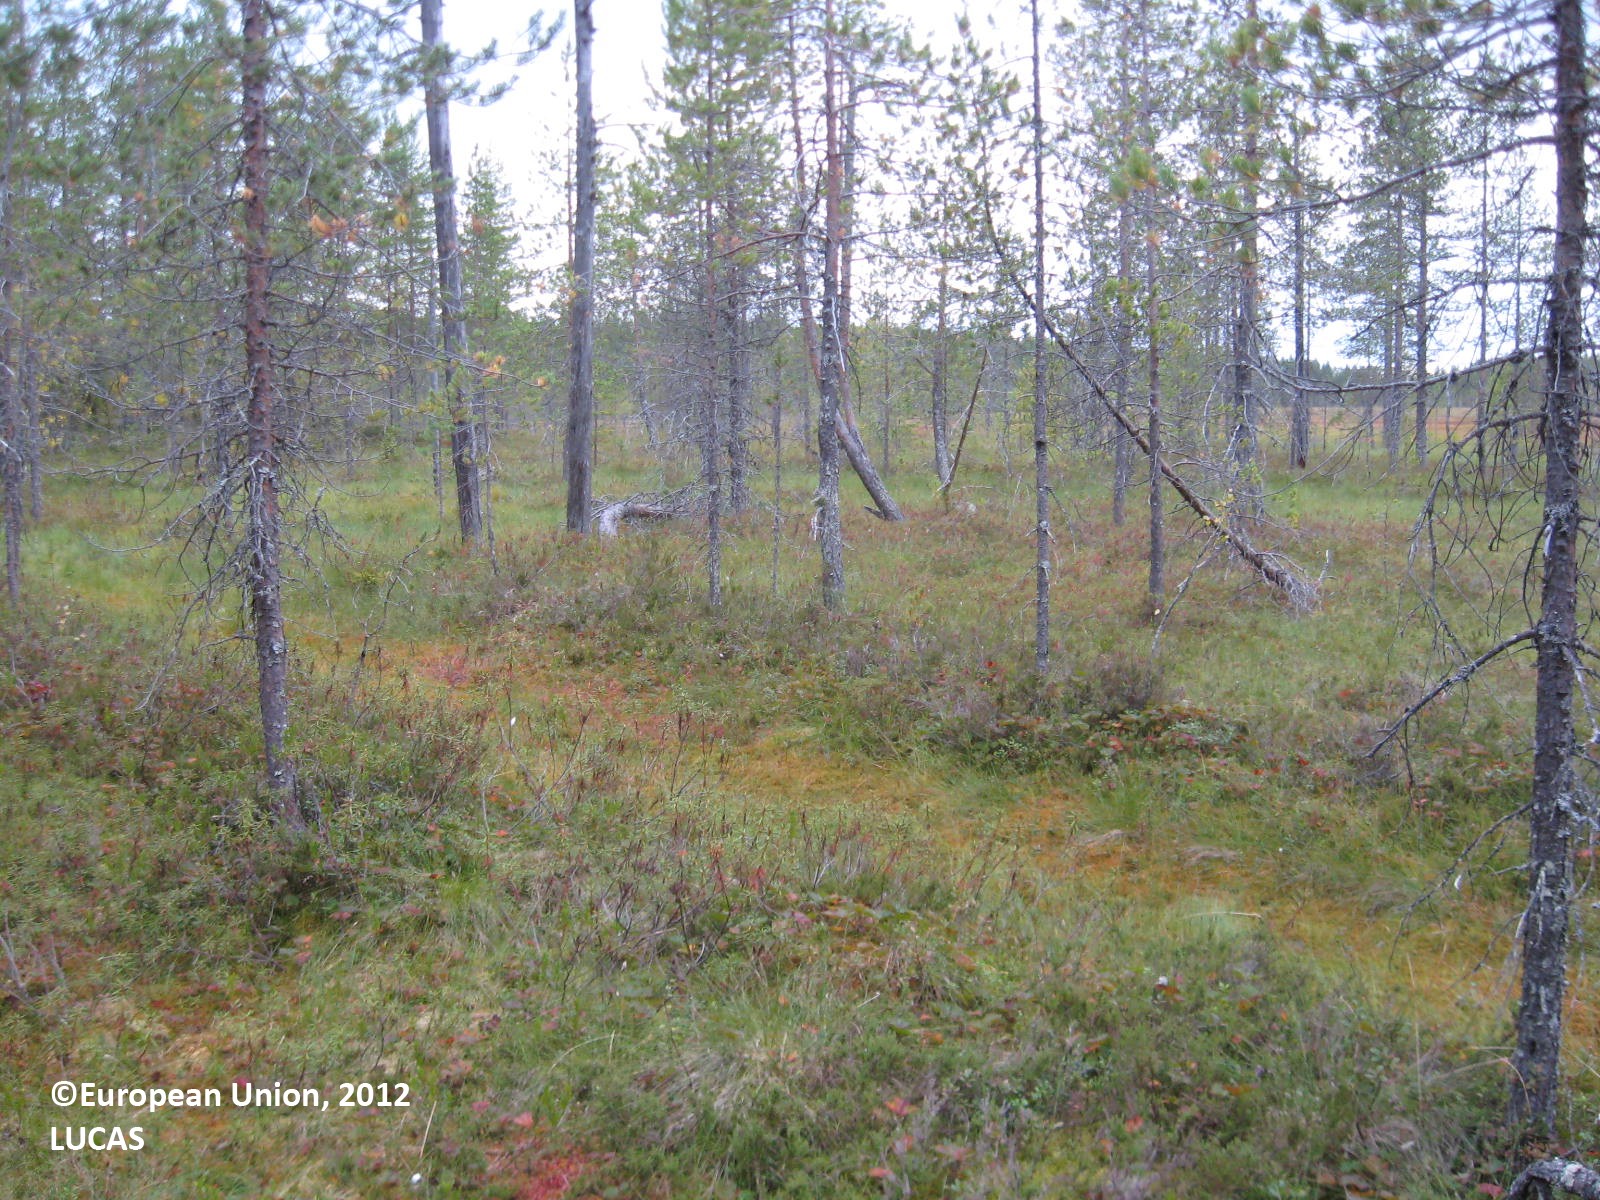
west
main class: Woodland
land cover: Pine dominated coniferous woodland
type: boreal forest
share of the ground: 50 - 75 %
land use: Semi-natural and natural areas not in use
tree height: > 5 m
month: August
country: FI
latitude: 63.7242
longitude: 29.6888
